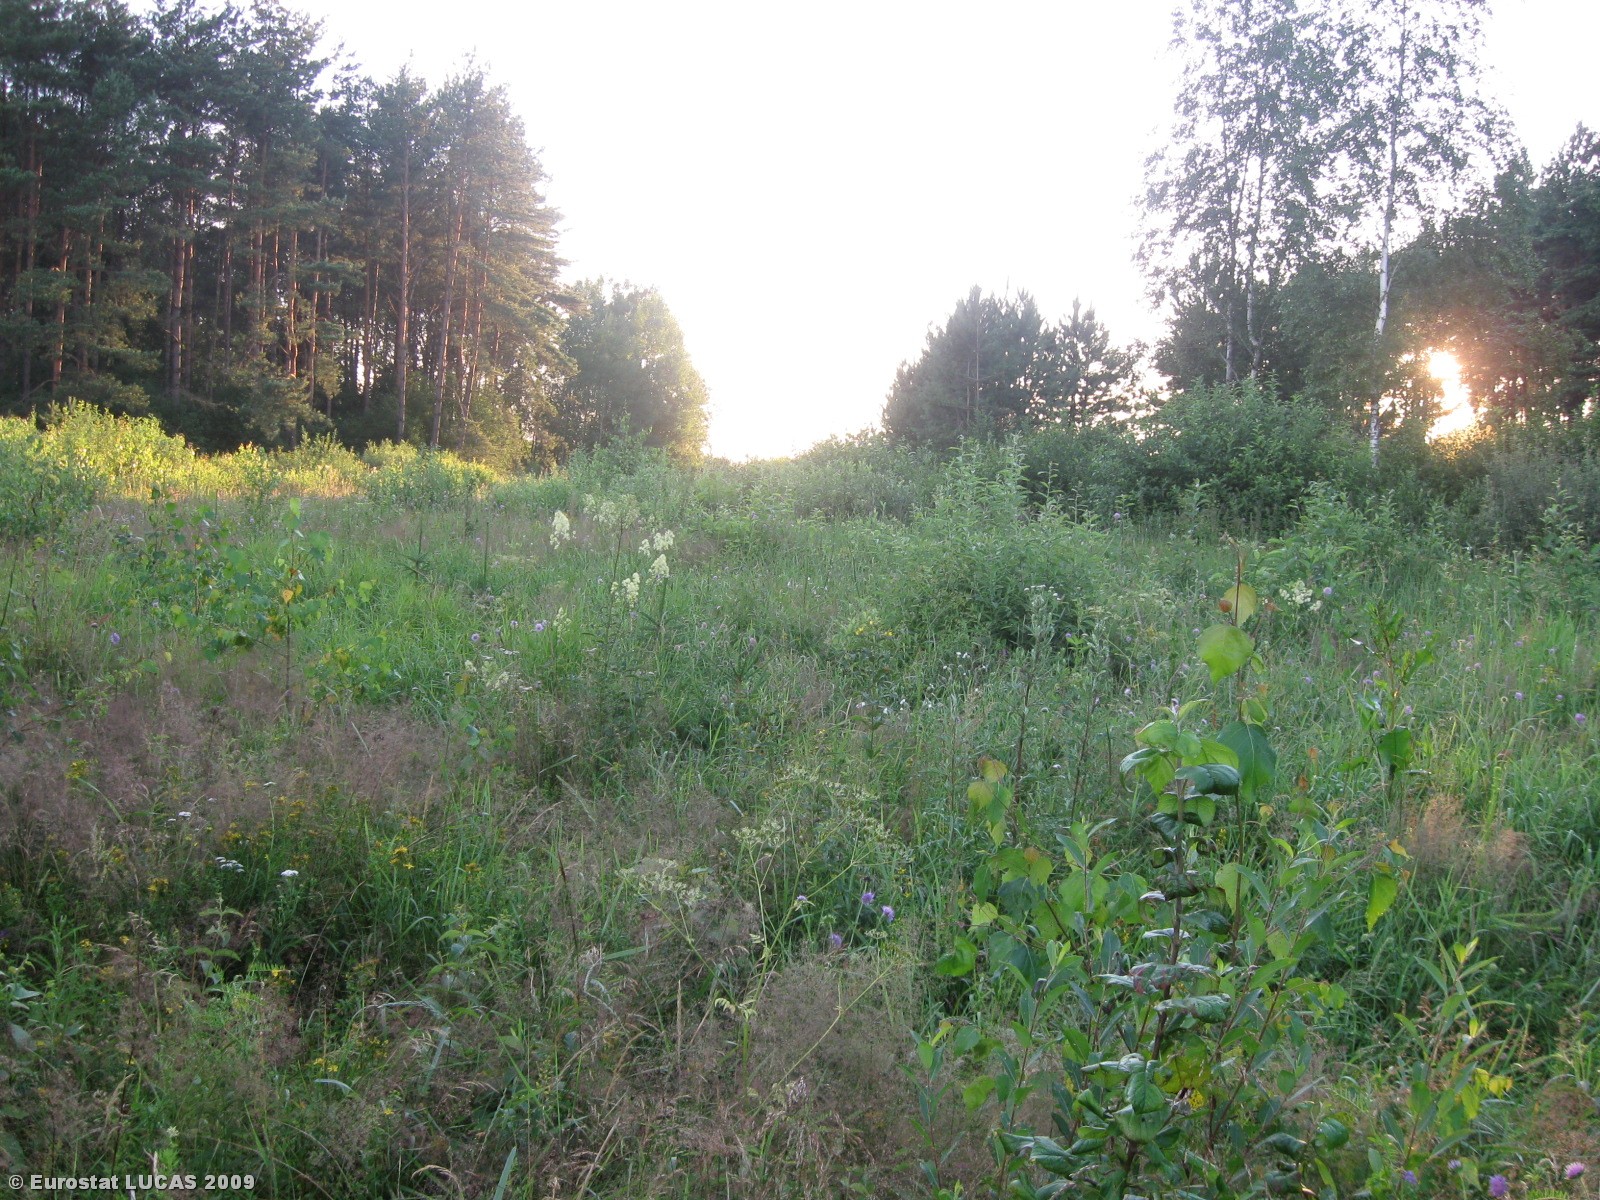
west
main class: Grassland
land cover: Grassland with sparse tree/shrub cover
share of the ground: > 75 %
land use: Forestry
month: July
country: LT
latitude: 54.5799
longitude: 25.3314
